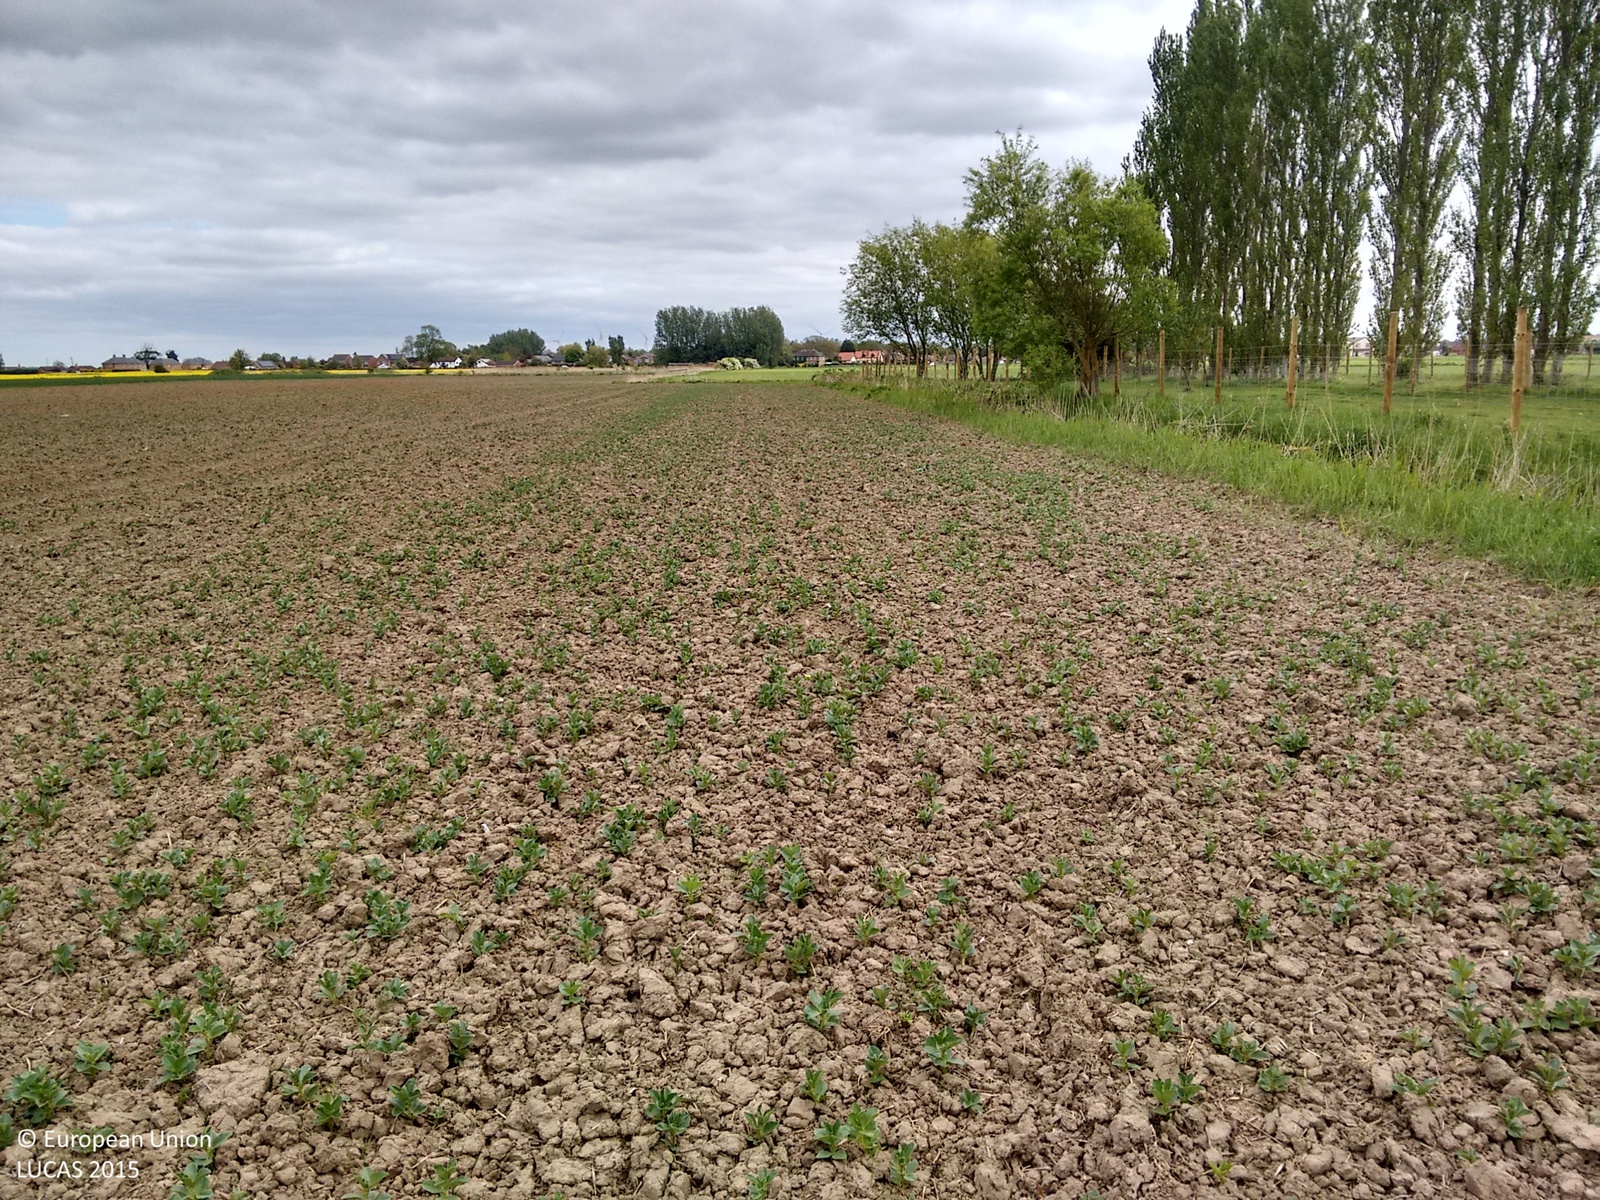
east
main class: Cropland
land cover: Dry pulses
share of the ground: 10 - 25 %
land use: Agriculture (excluding fallow land and kitchen gardens)
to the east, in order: Dry pulses; Grass margins; Ditches and canals; Grass margins; Artificial constructions in urban areas; Grass margins; Ditches and canals; Grass margins; Dry pulses
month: May
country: GB
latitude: 52.7432
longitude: 0.1184
